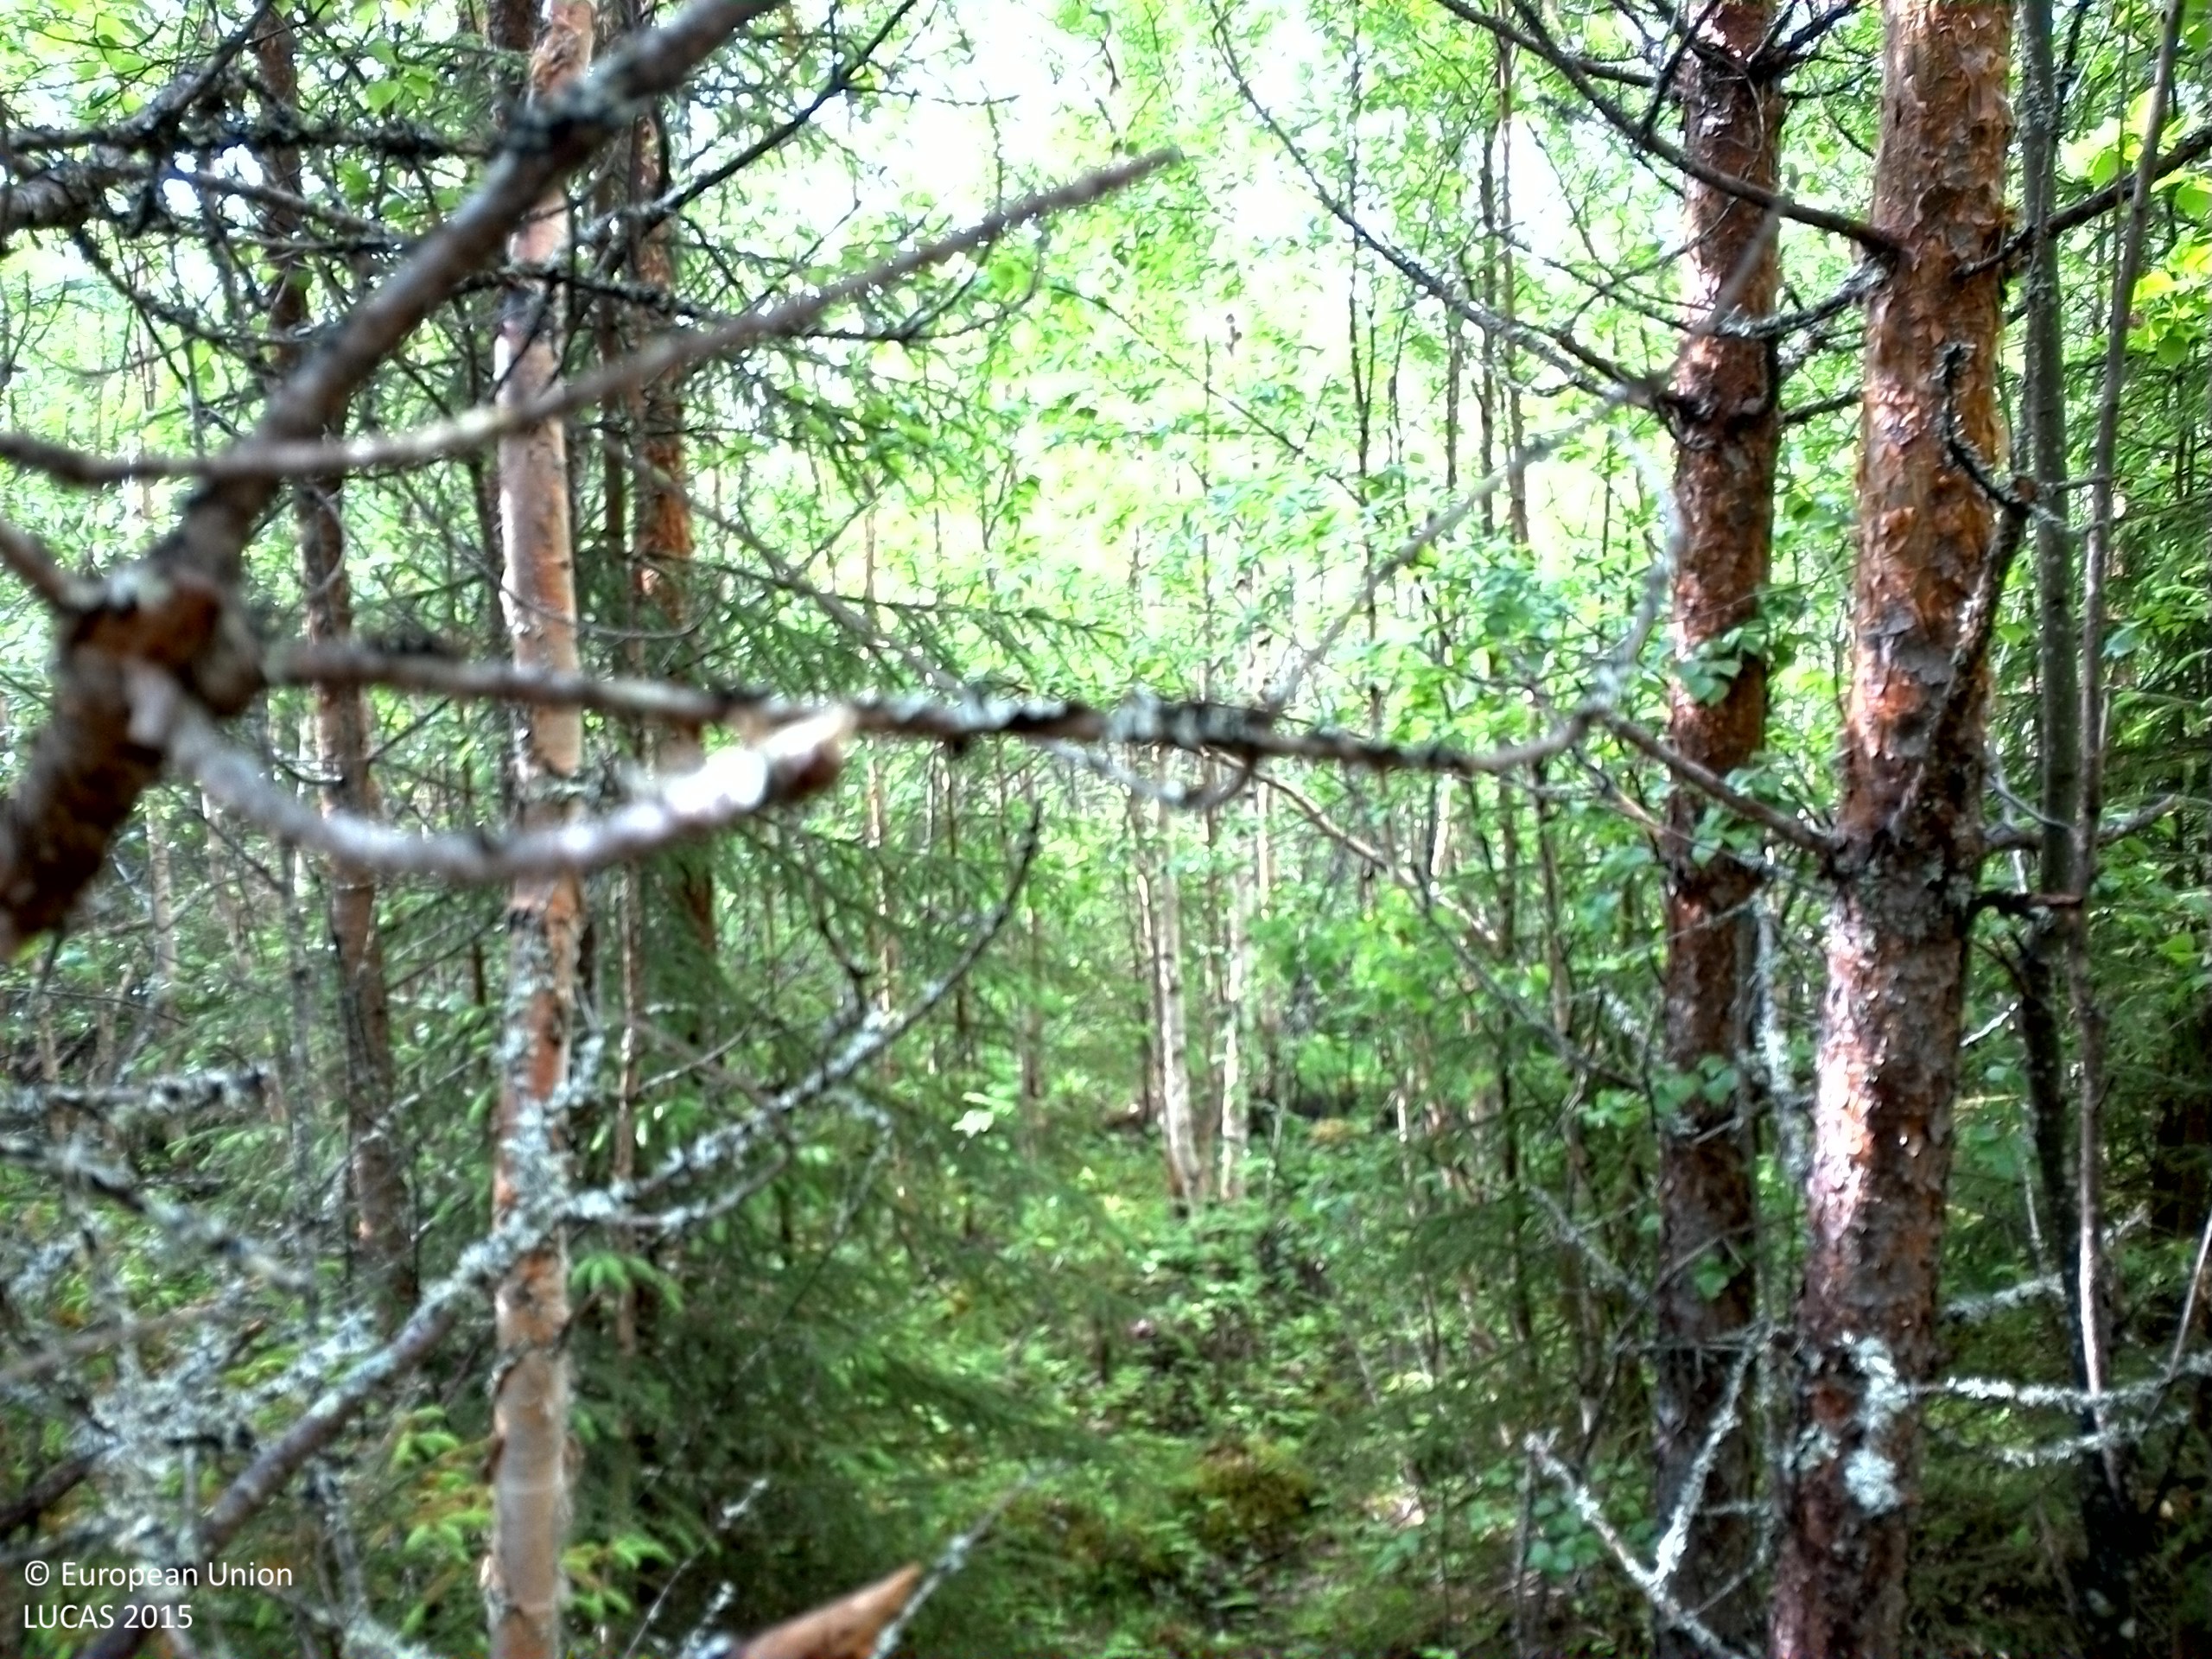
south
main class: Woodland
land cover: Pine dominated mixed woodland
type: boreal forest
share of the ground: 50 - 75 %
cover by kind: coniferous forest trees 40 %, broadleaved forest trees 30 %, shrubs 25 %, lichens and mosses 5 %
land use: Forestry
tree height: > 5 m
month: June
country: SE
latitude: 63.4847
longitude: 18.0661
